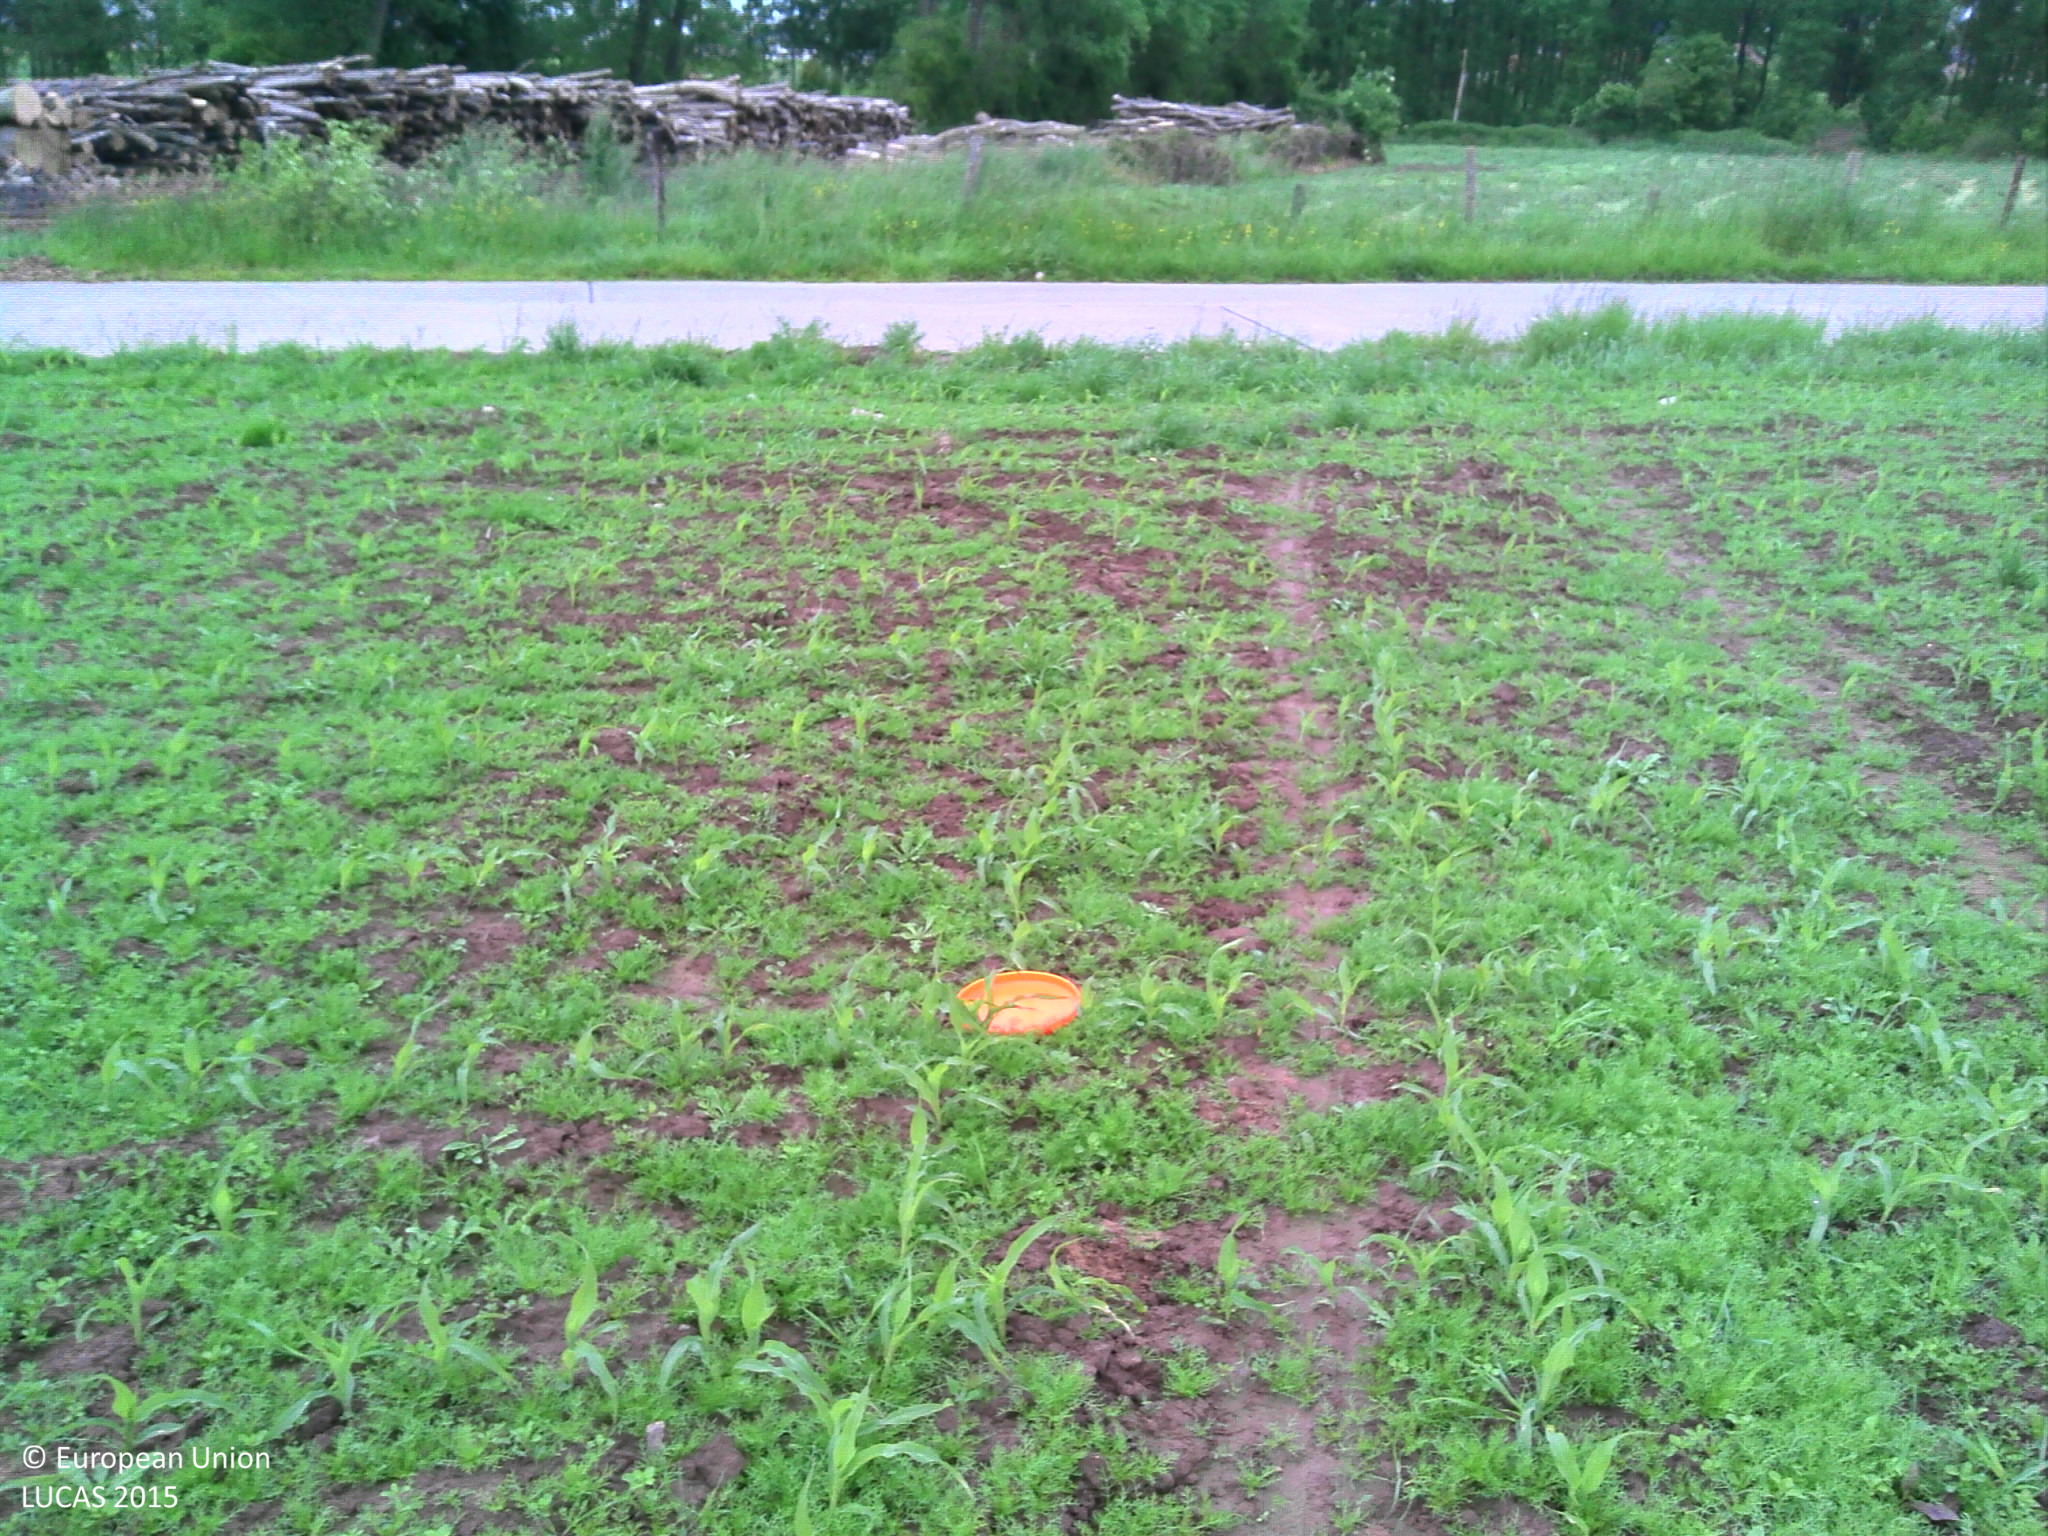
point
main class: Cropland
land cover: Maize
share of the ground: 10 - 25 %
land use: Agriculture (excluding fallow land and kitchen gardens)
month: June
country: BE
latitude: 50.8131
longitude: 3.8767
